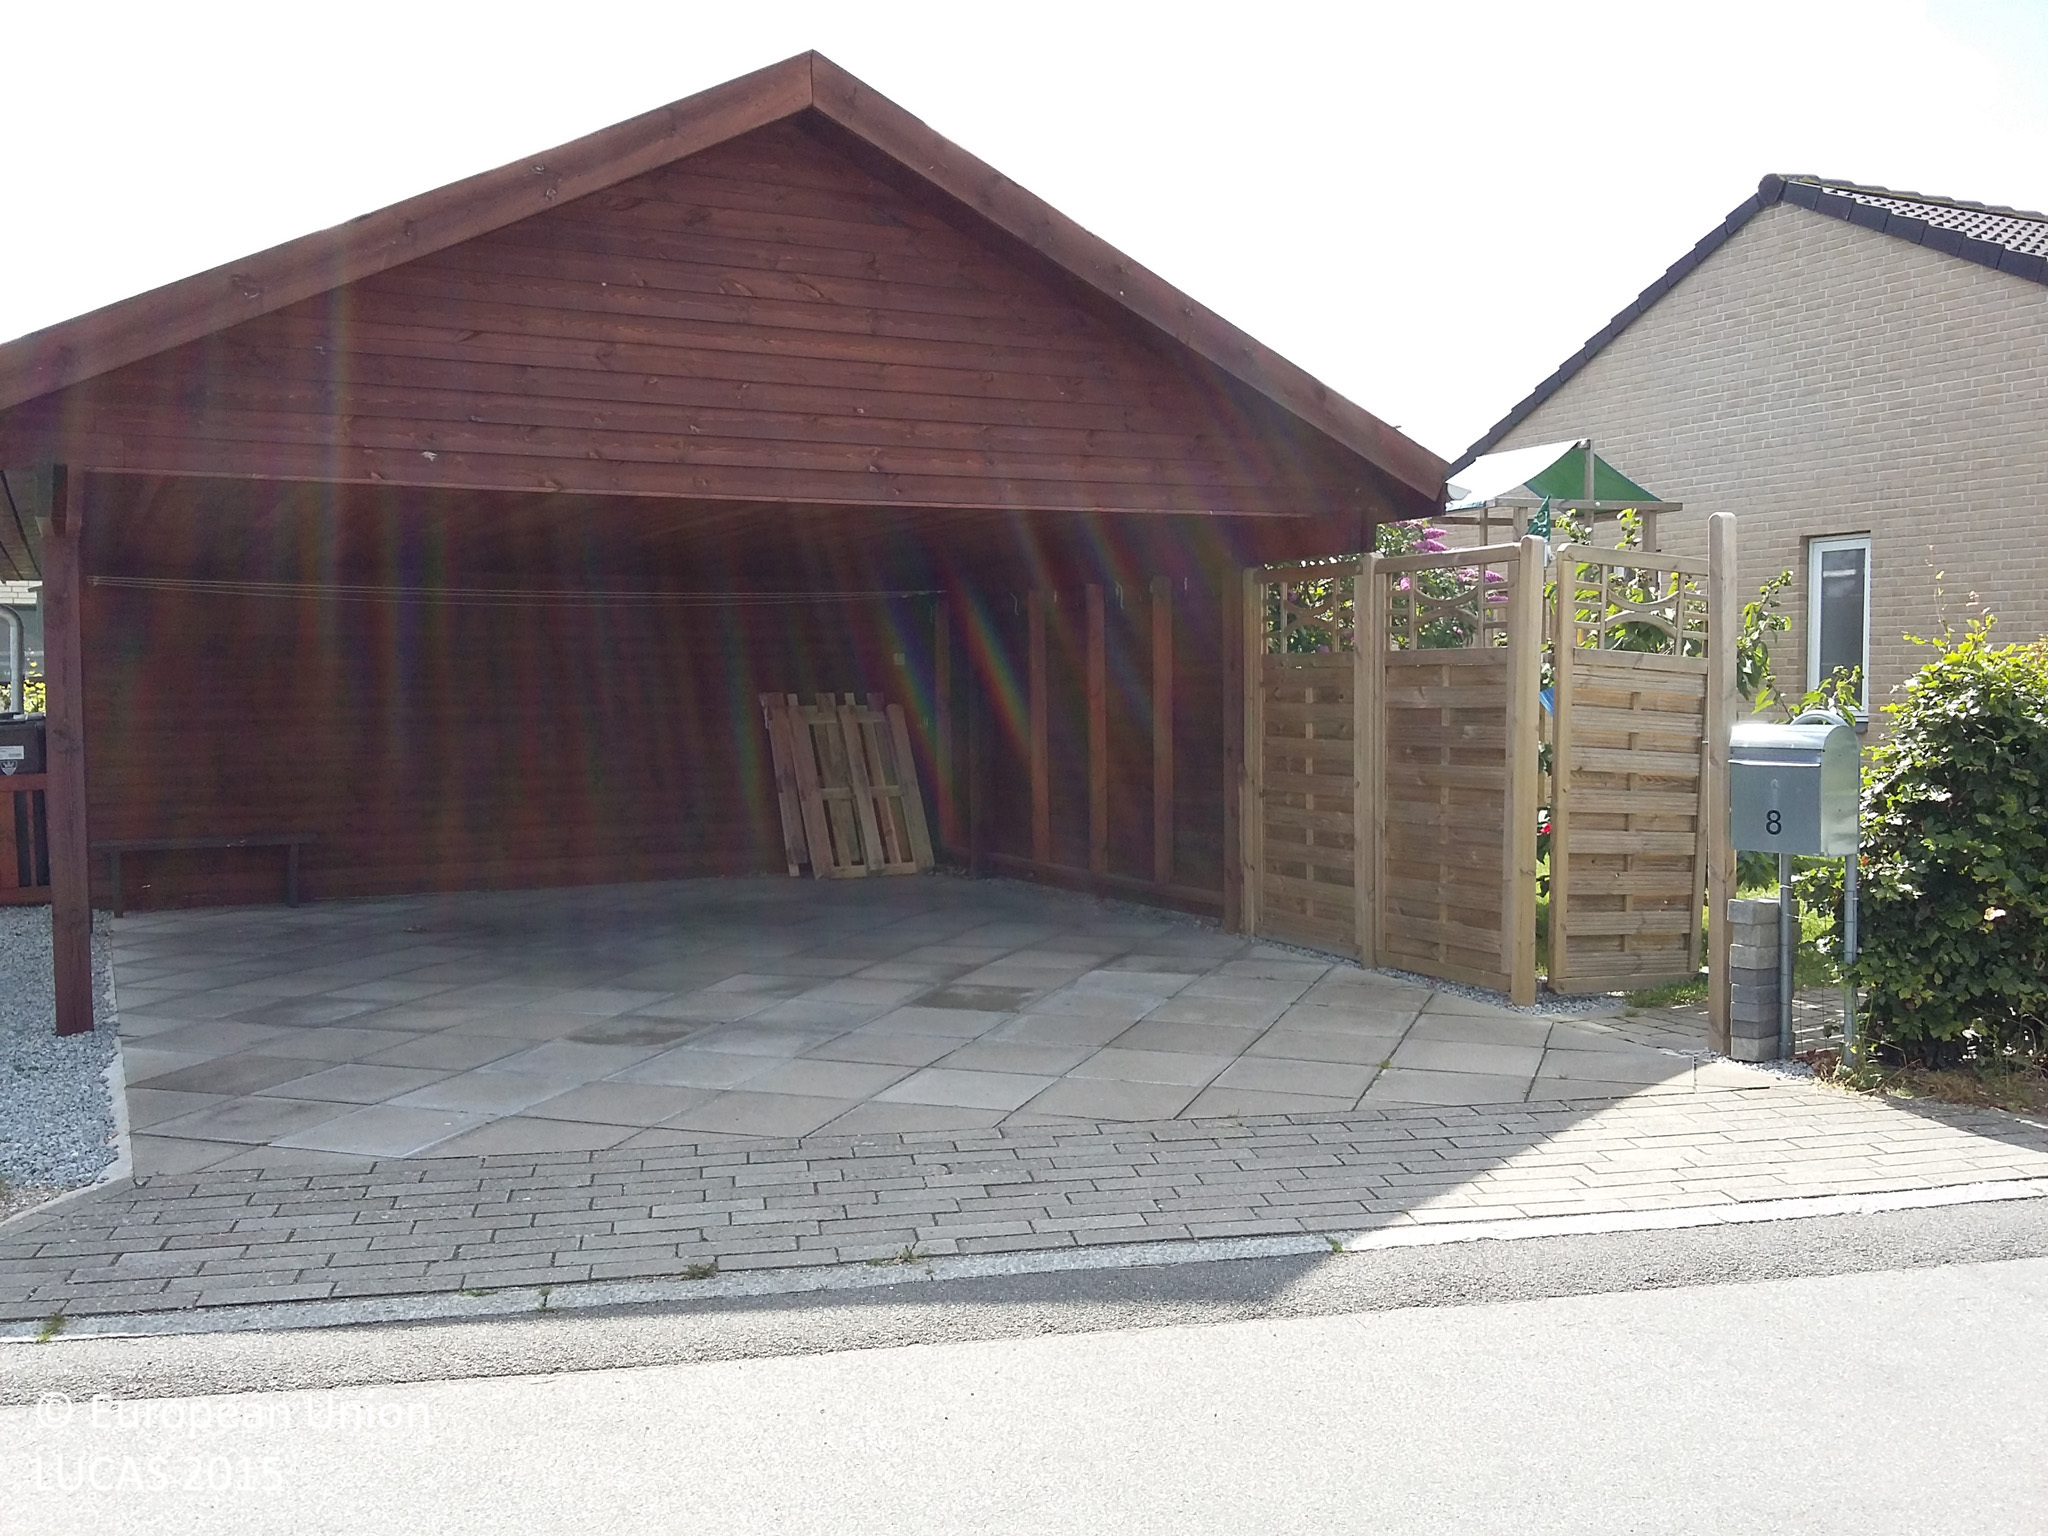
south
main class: Grassland
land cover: Grassland without tree/shrub cover
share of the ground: > 75 %
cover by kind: herbaceous plants 100 %
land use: Residential
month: August
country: DK
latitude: 55.4127
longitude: 12.2571
